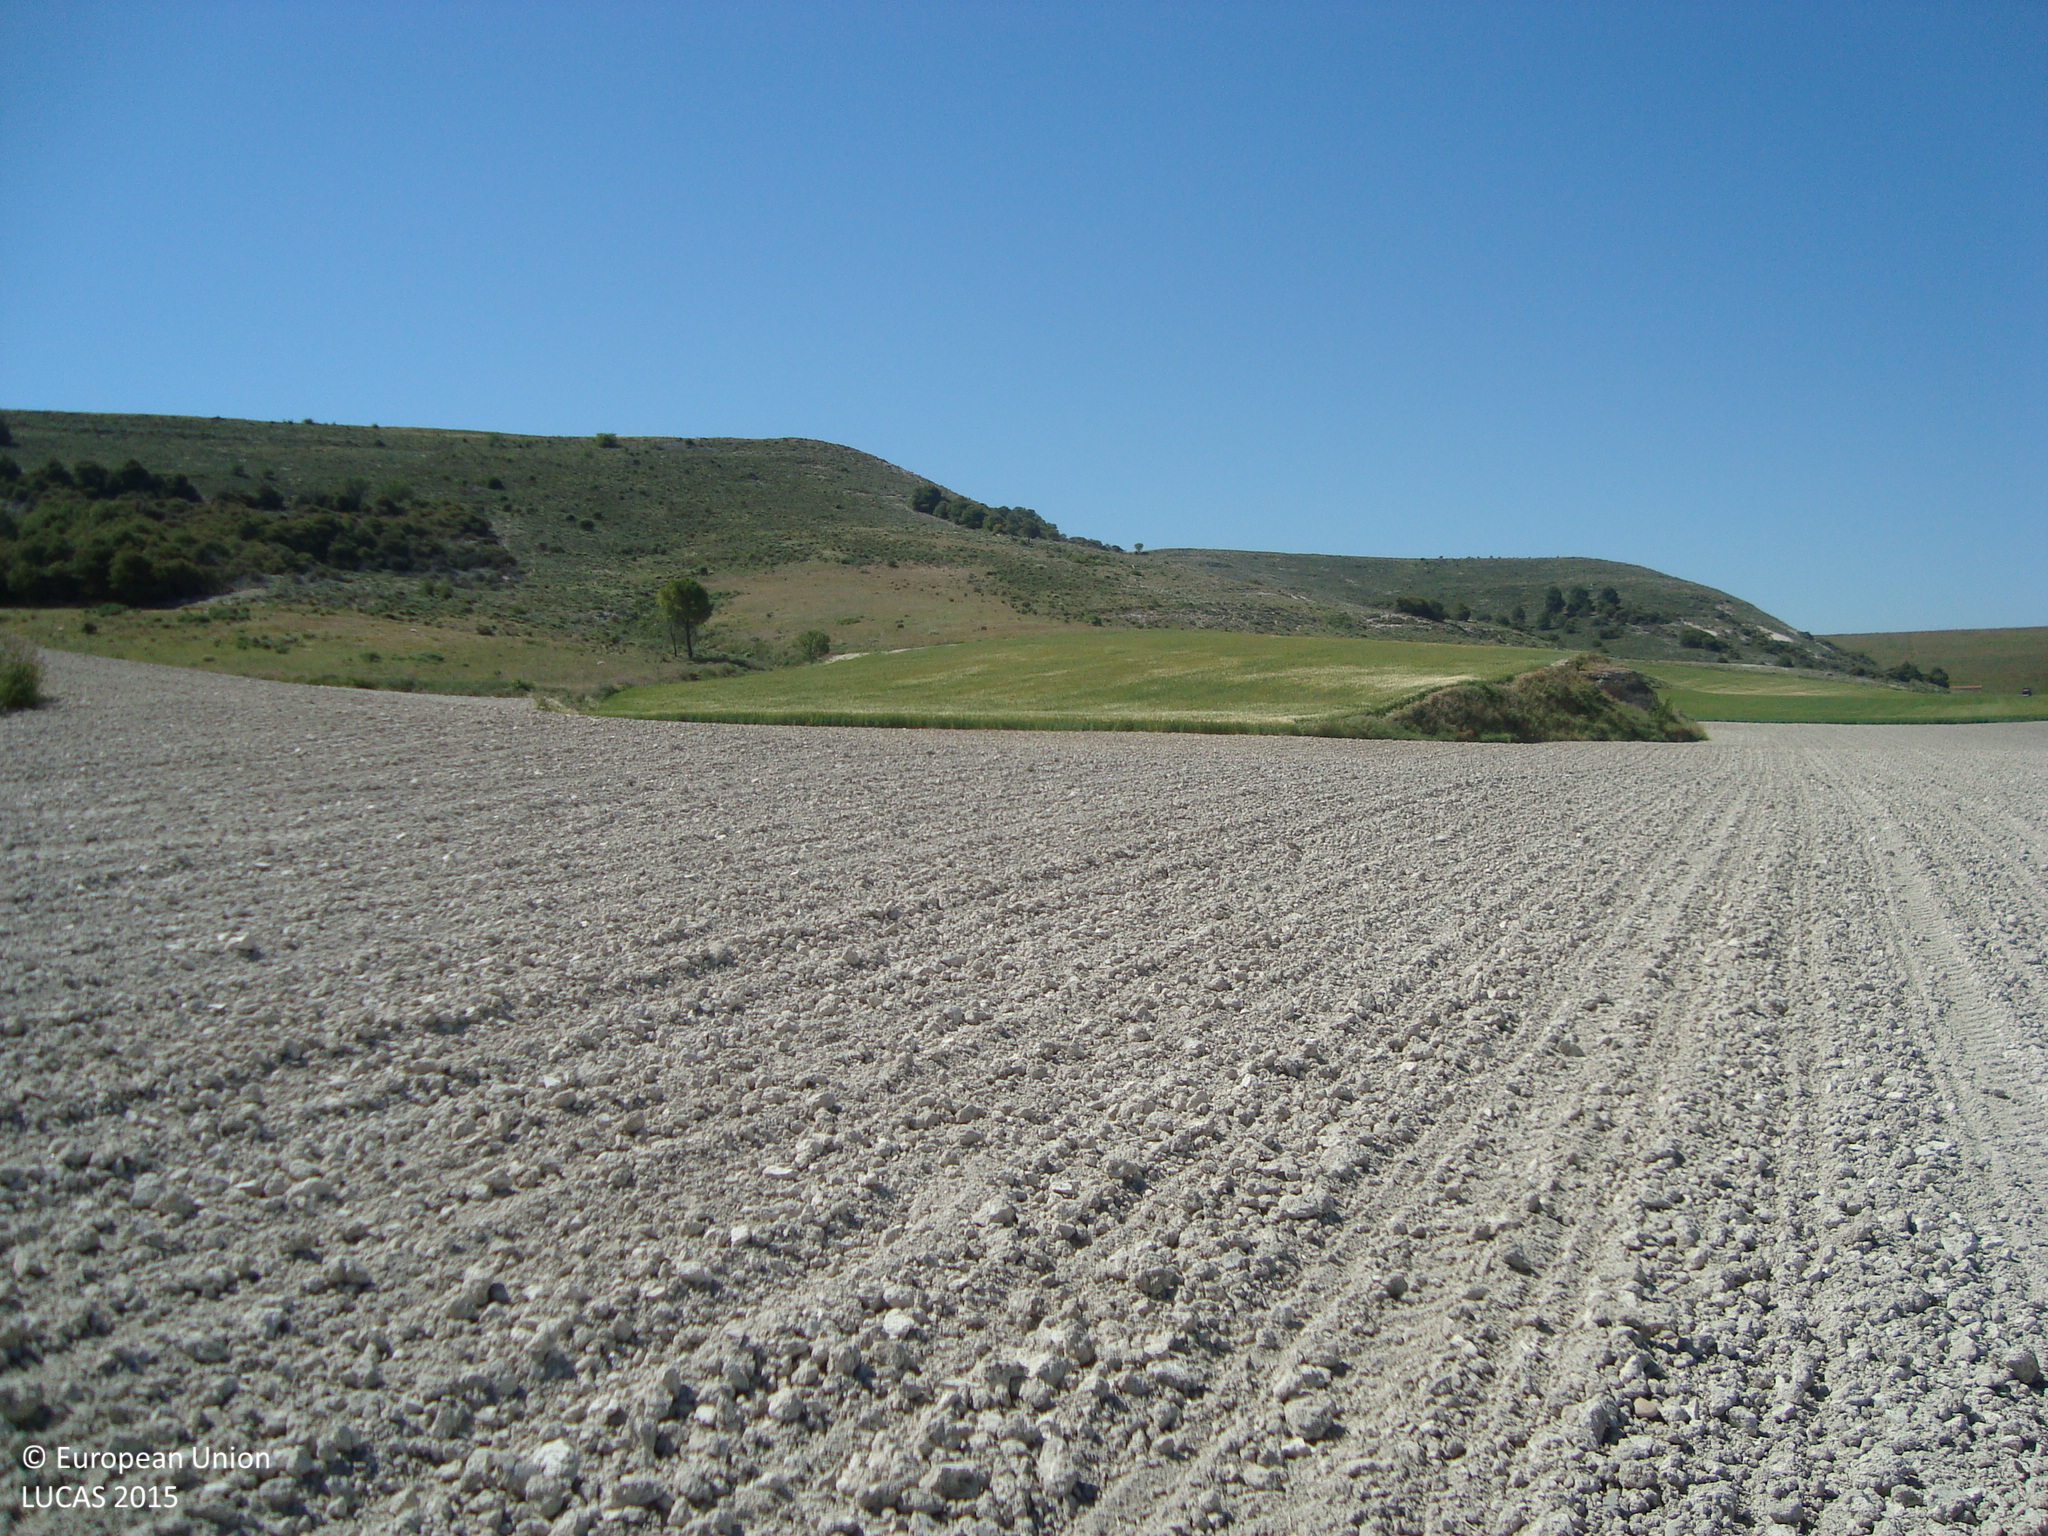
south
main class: Cropland
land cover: Sunflower
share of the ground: < 10 %
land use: Agriculture (excluding fallow land and kitchen gardens)
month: May
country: ES
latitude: 41.5814
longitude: -4.1523
